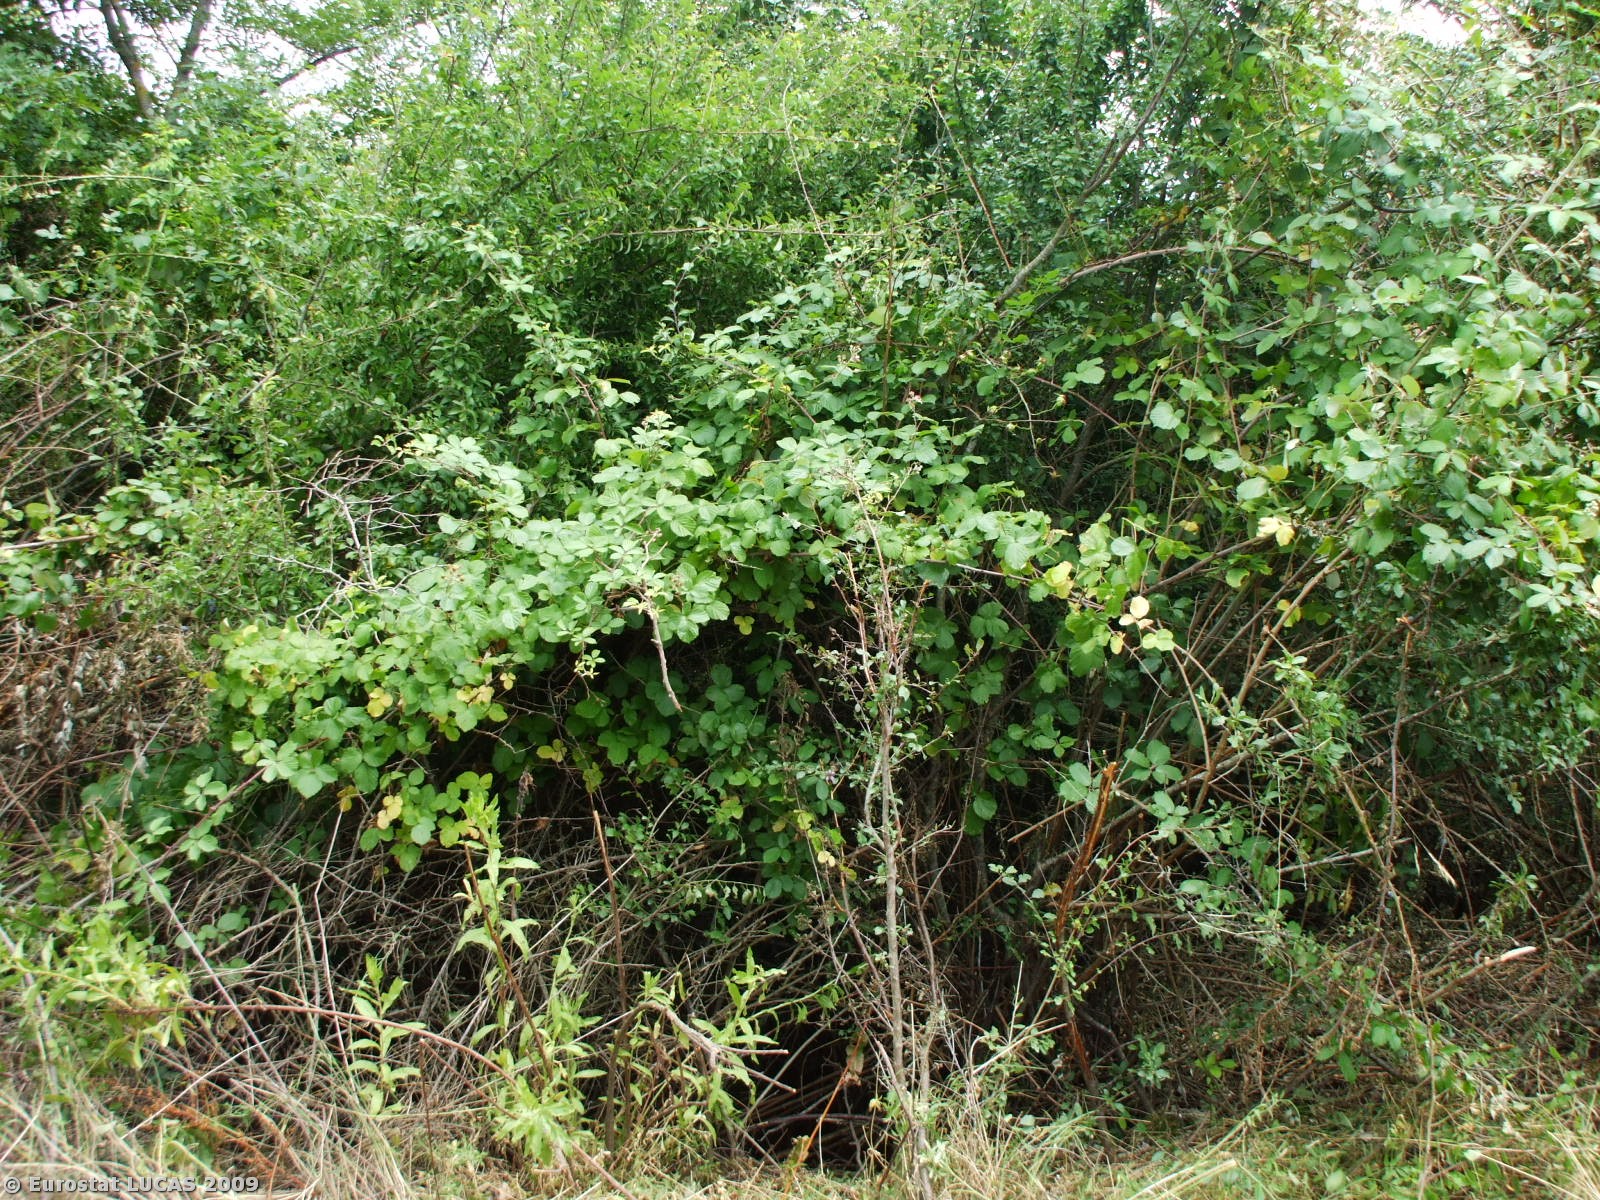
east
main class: Shrubland
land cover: Shrubland with sparse tree cover
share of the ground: > 75 %
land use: Unused
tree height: > 5 m
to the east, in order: Shrubland with sparse tree cover; Shrubland without tree cover; Grassland without tree/shrub cover; Broadleaved woodland; Grassland without tree/shrub cover; Shrubland with sparse tree cover; Broadleaved woodland
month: June
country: IT
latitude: 43.5251
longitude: 11.6658
